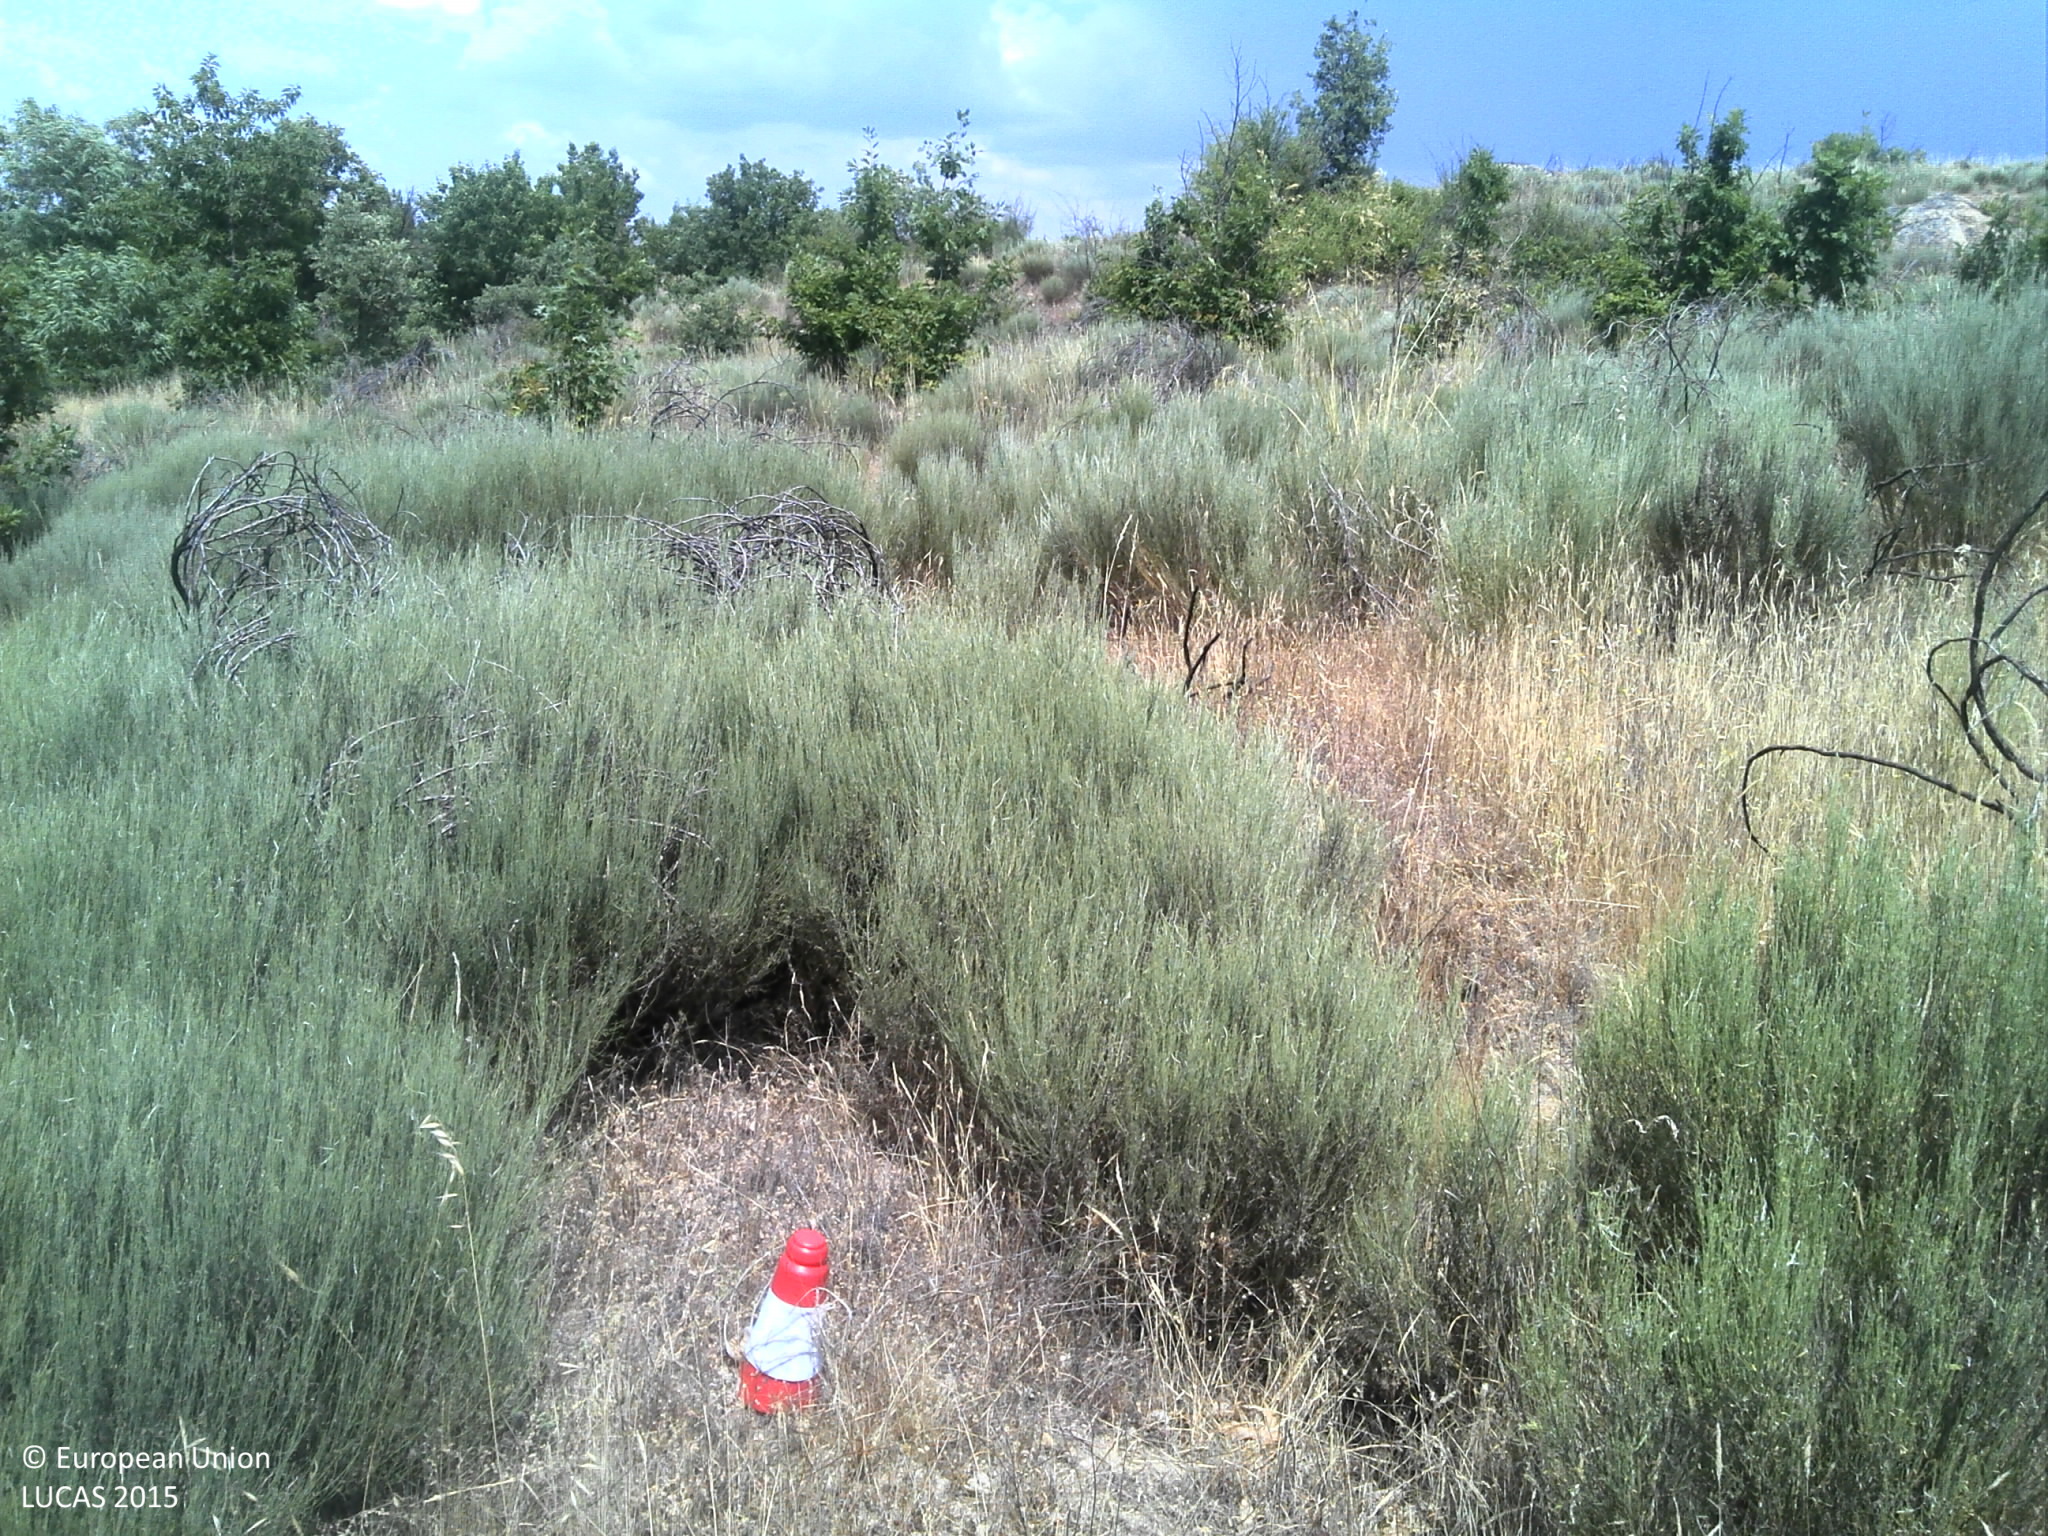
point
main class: Shrubland
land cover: Shrubland without tree cover
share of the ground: 50 - 75 %
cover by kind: shrubs 60 %, herbaceous plants 30 %, unconsolidated bare surface 5 %
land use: Abandoned areas
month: June
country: PT
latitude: 40.3011
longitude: -7.3154
